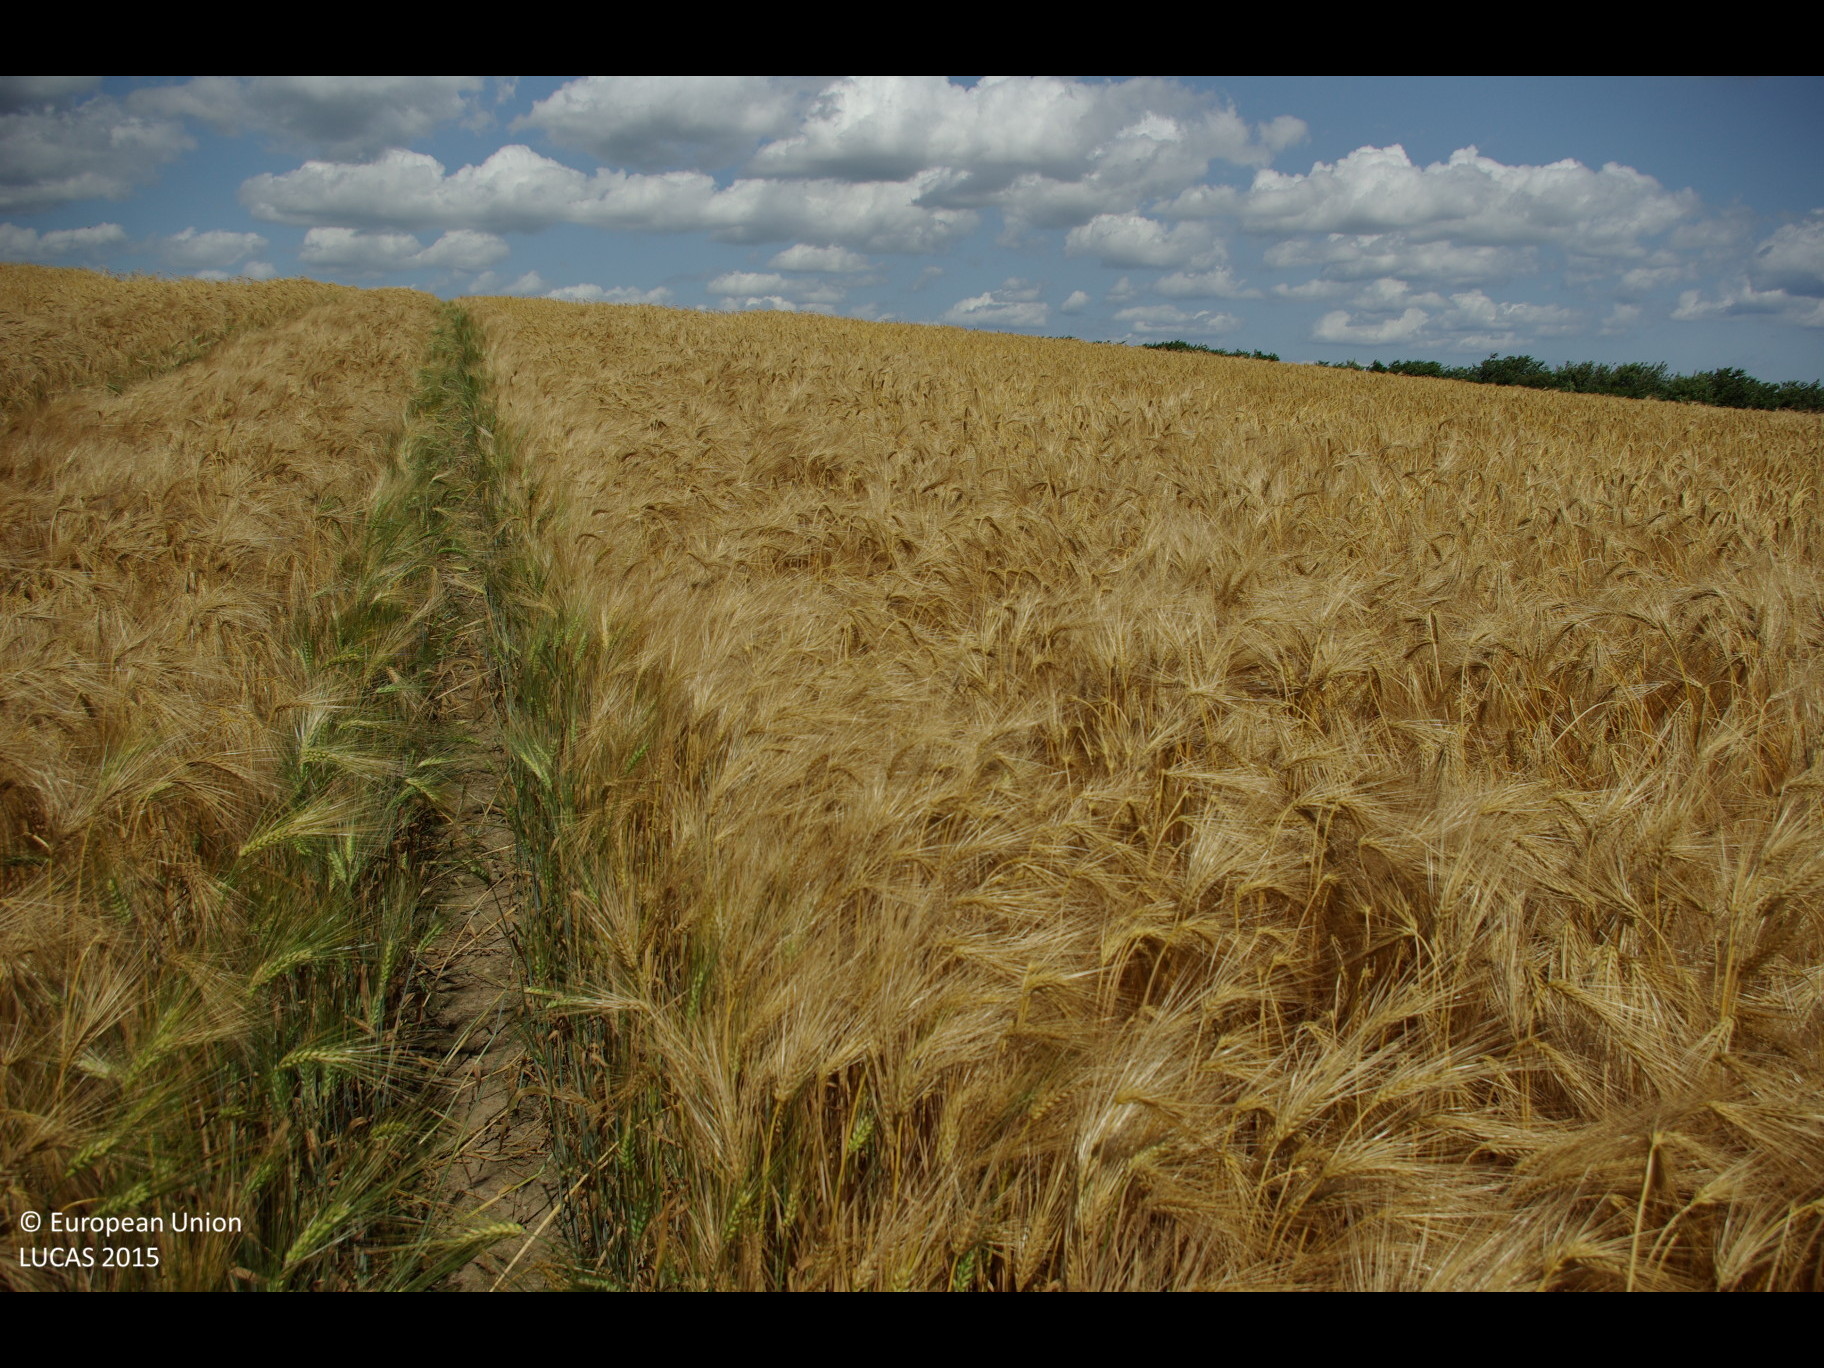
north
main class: Cropland
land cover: Barley
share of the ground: > 75 %
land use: Agriculture (excluding fallow land and kitchen gardens)
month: July
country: DE
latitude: 54.5521
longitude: 9.9227
